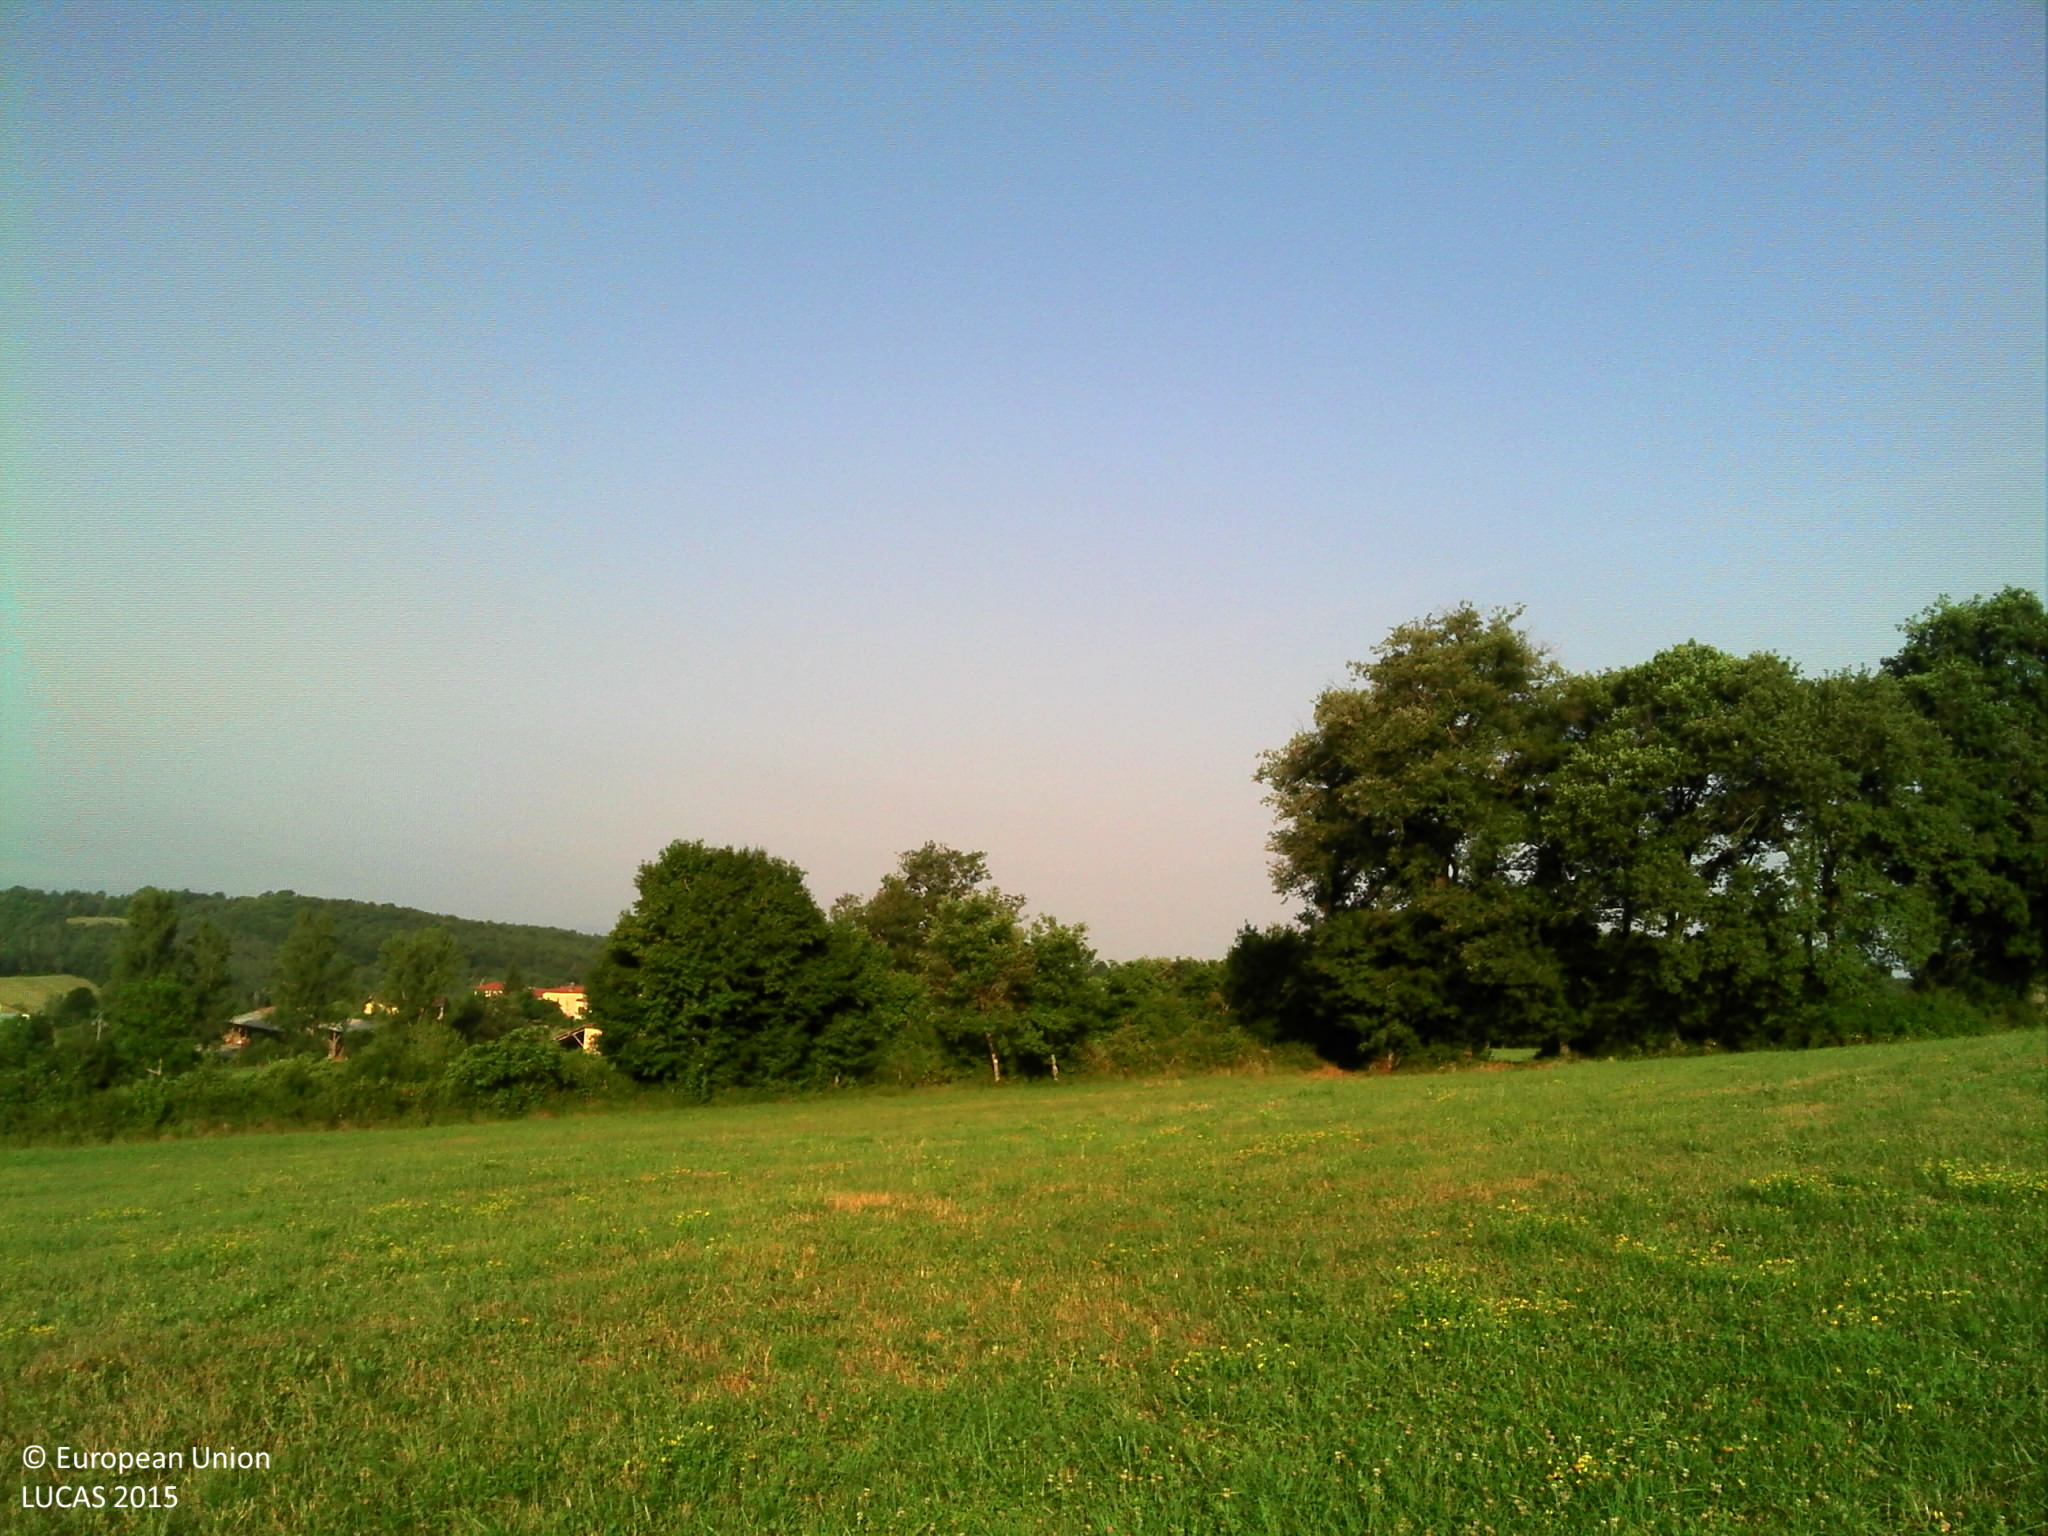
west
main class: Grassland
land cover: Grassland without tree/shrub cover
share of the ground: > 75 %
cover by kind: herbaceous plants 100 %
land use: Agriculture (excluding fallow land and kitchen gardens)
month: July
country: FR
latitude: 43.1300
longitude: 1.0667
